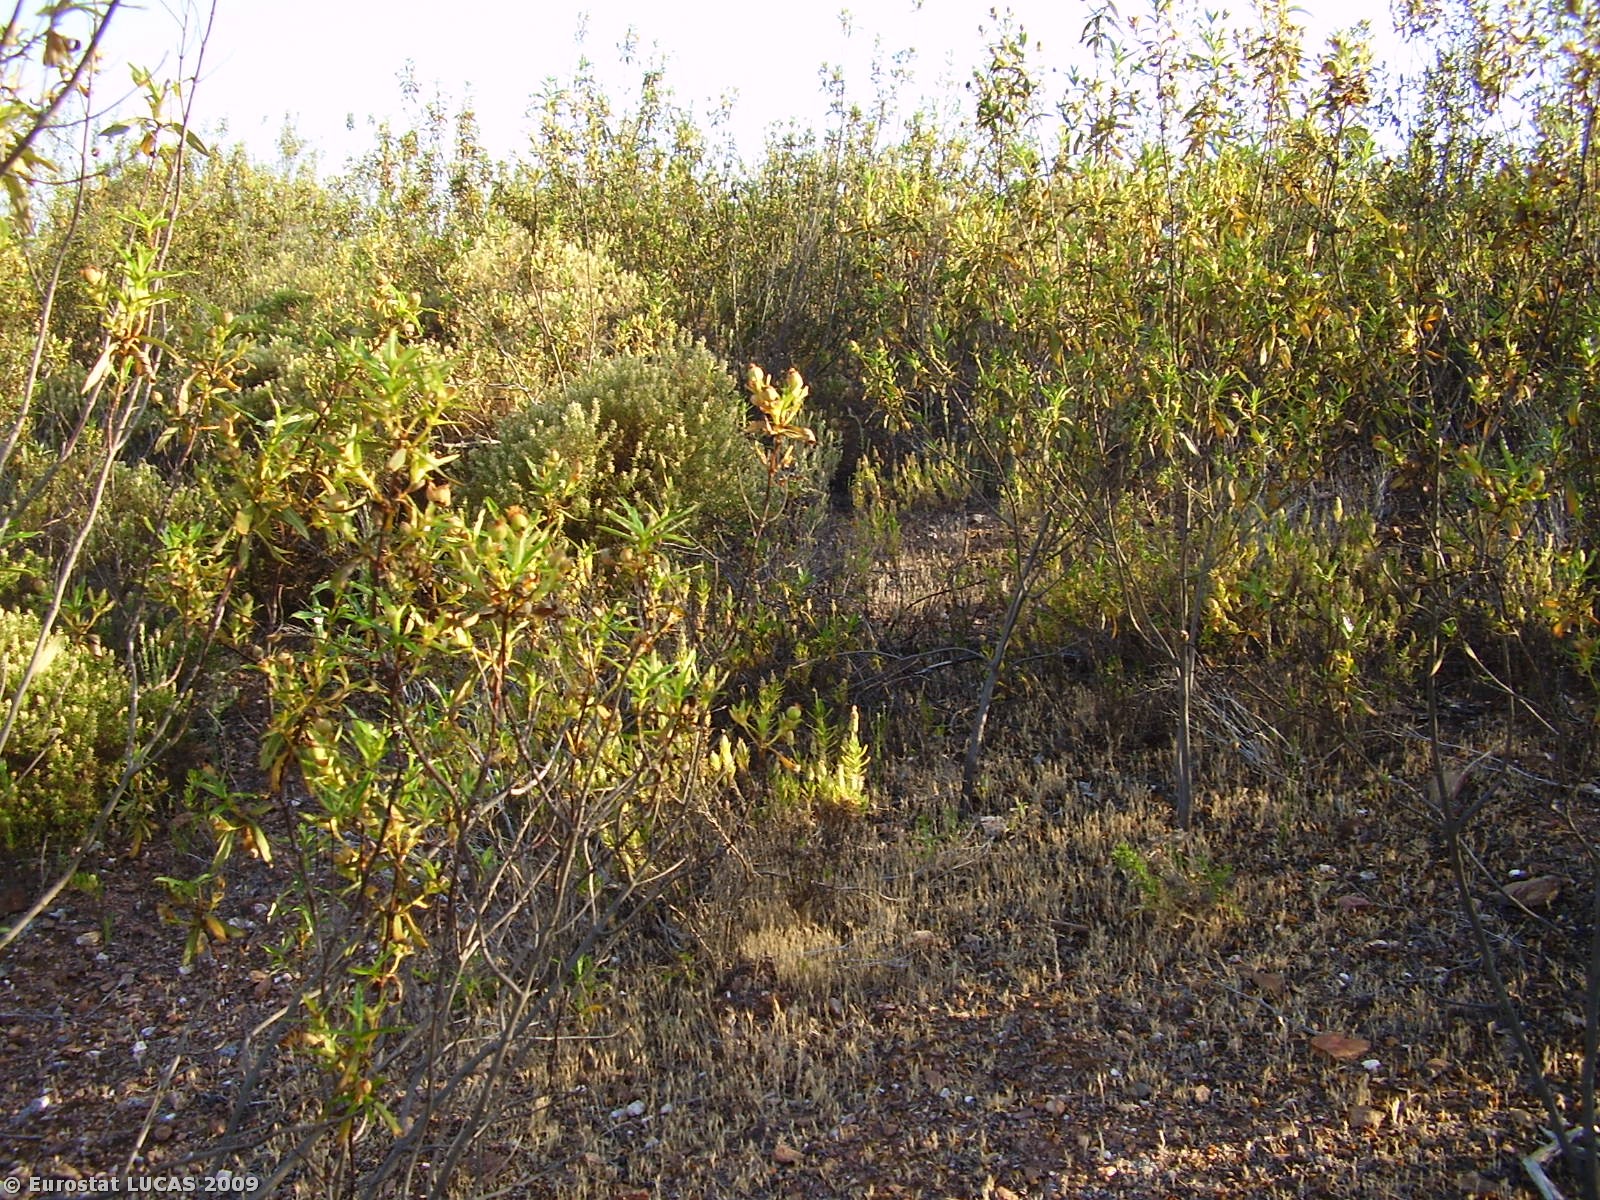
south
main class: Shrubland
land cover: Shrubland with sparse tree cover
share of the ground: 50 - 75 %
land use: Fallow land
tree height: > 5 m
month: May
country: PT
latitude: 37.7776
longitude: -7.4879
